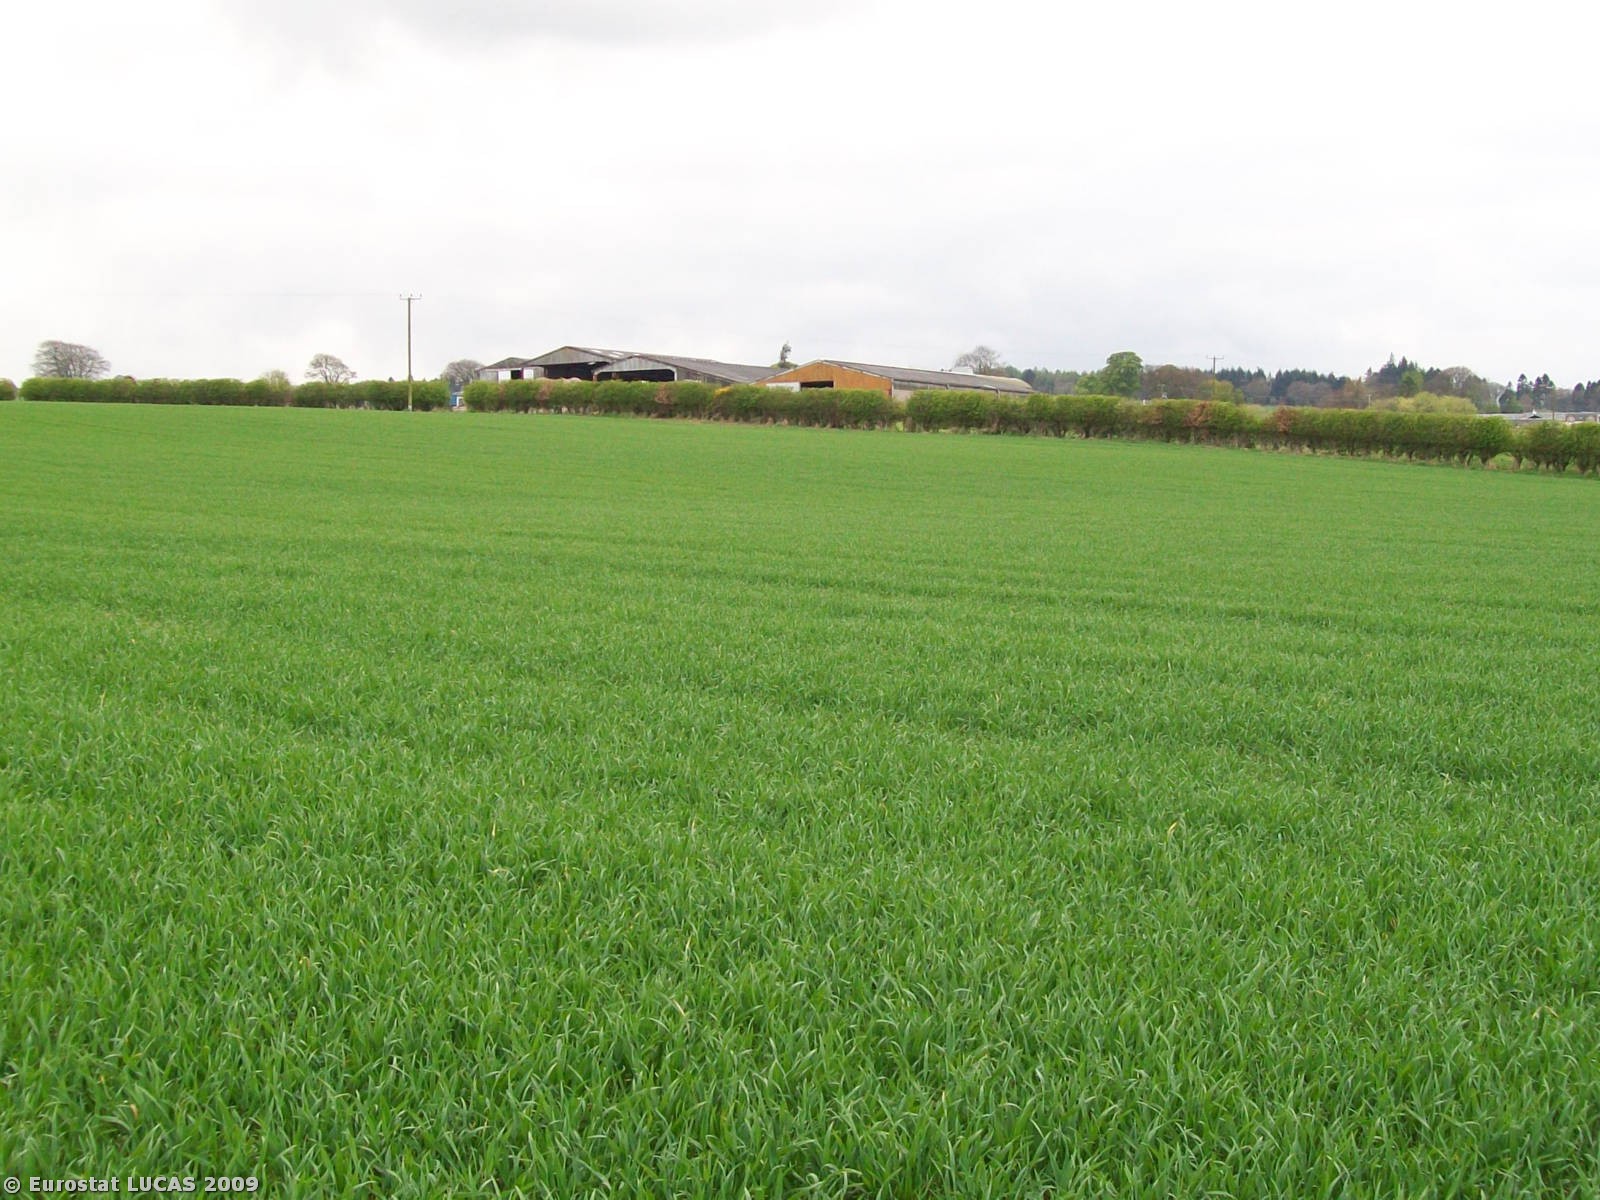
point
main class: Cropland
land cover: Common wheat
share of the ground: 50 - 75 %
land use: Agriculture (excluding fallow land and kitchen gardens)
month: April
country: GB
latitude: 56.3029
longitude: -3.7371
